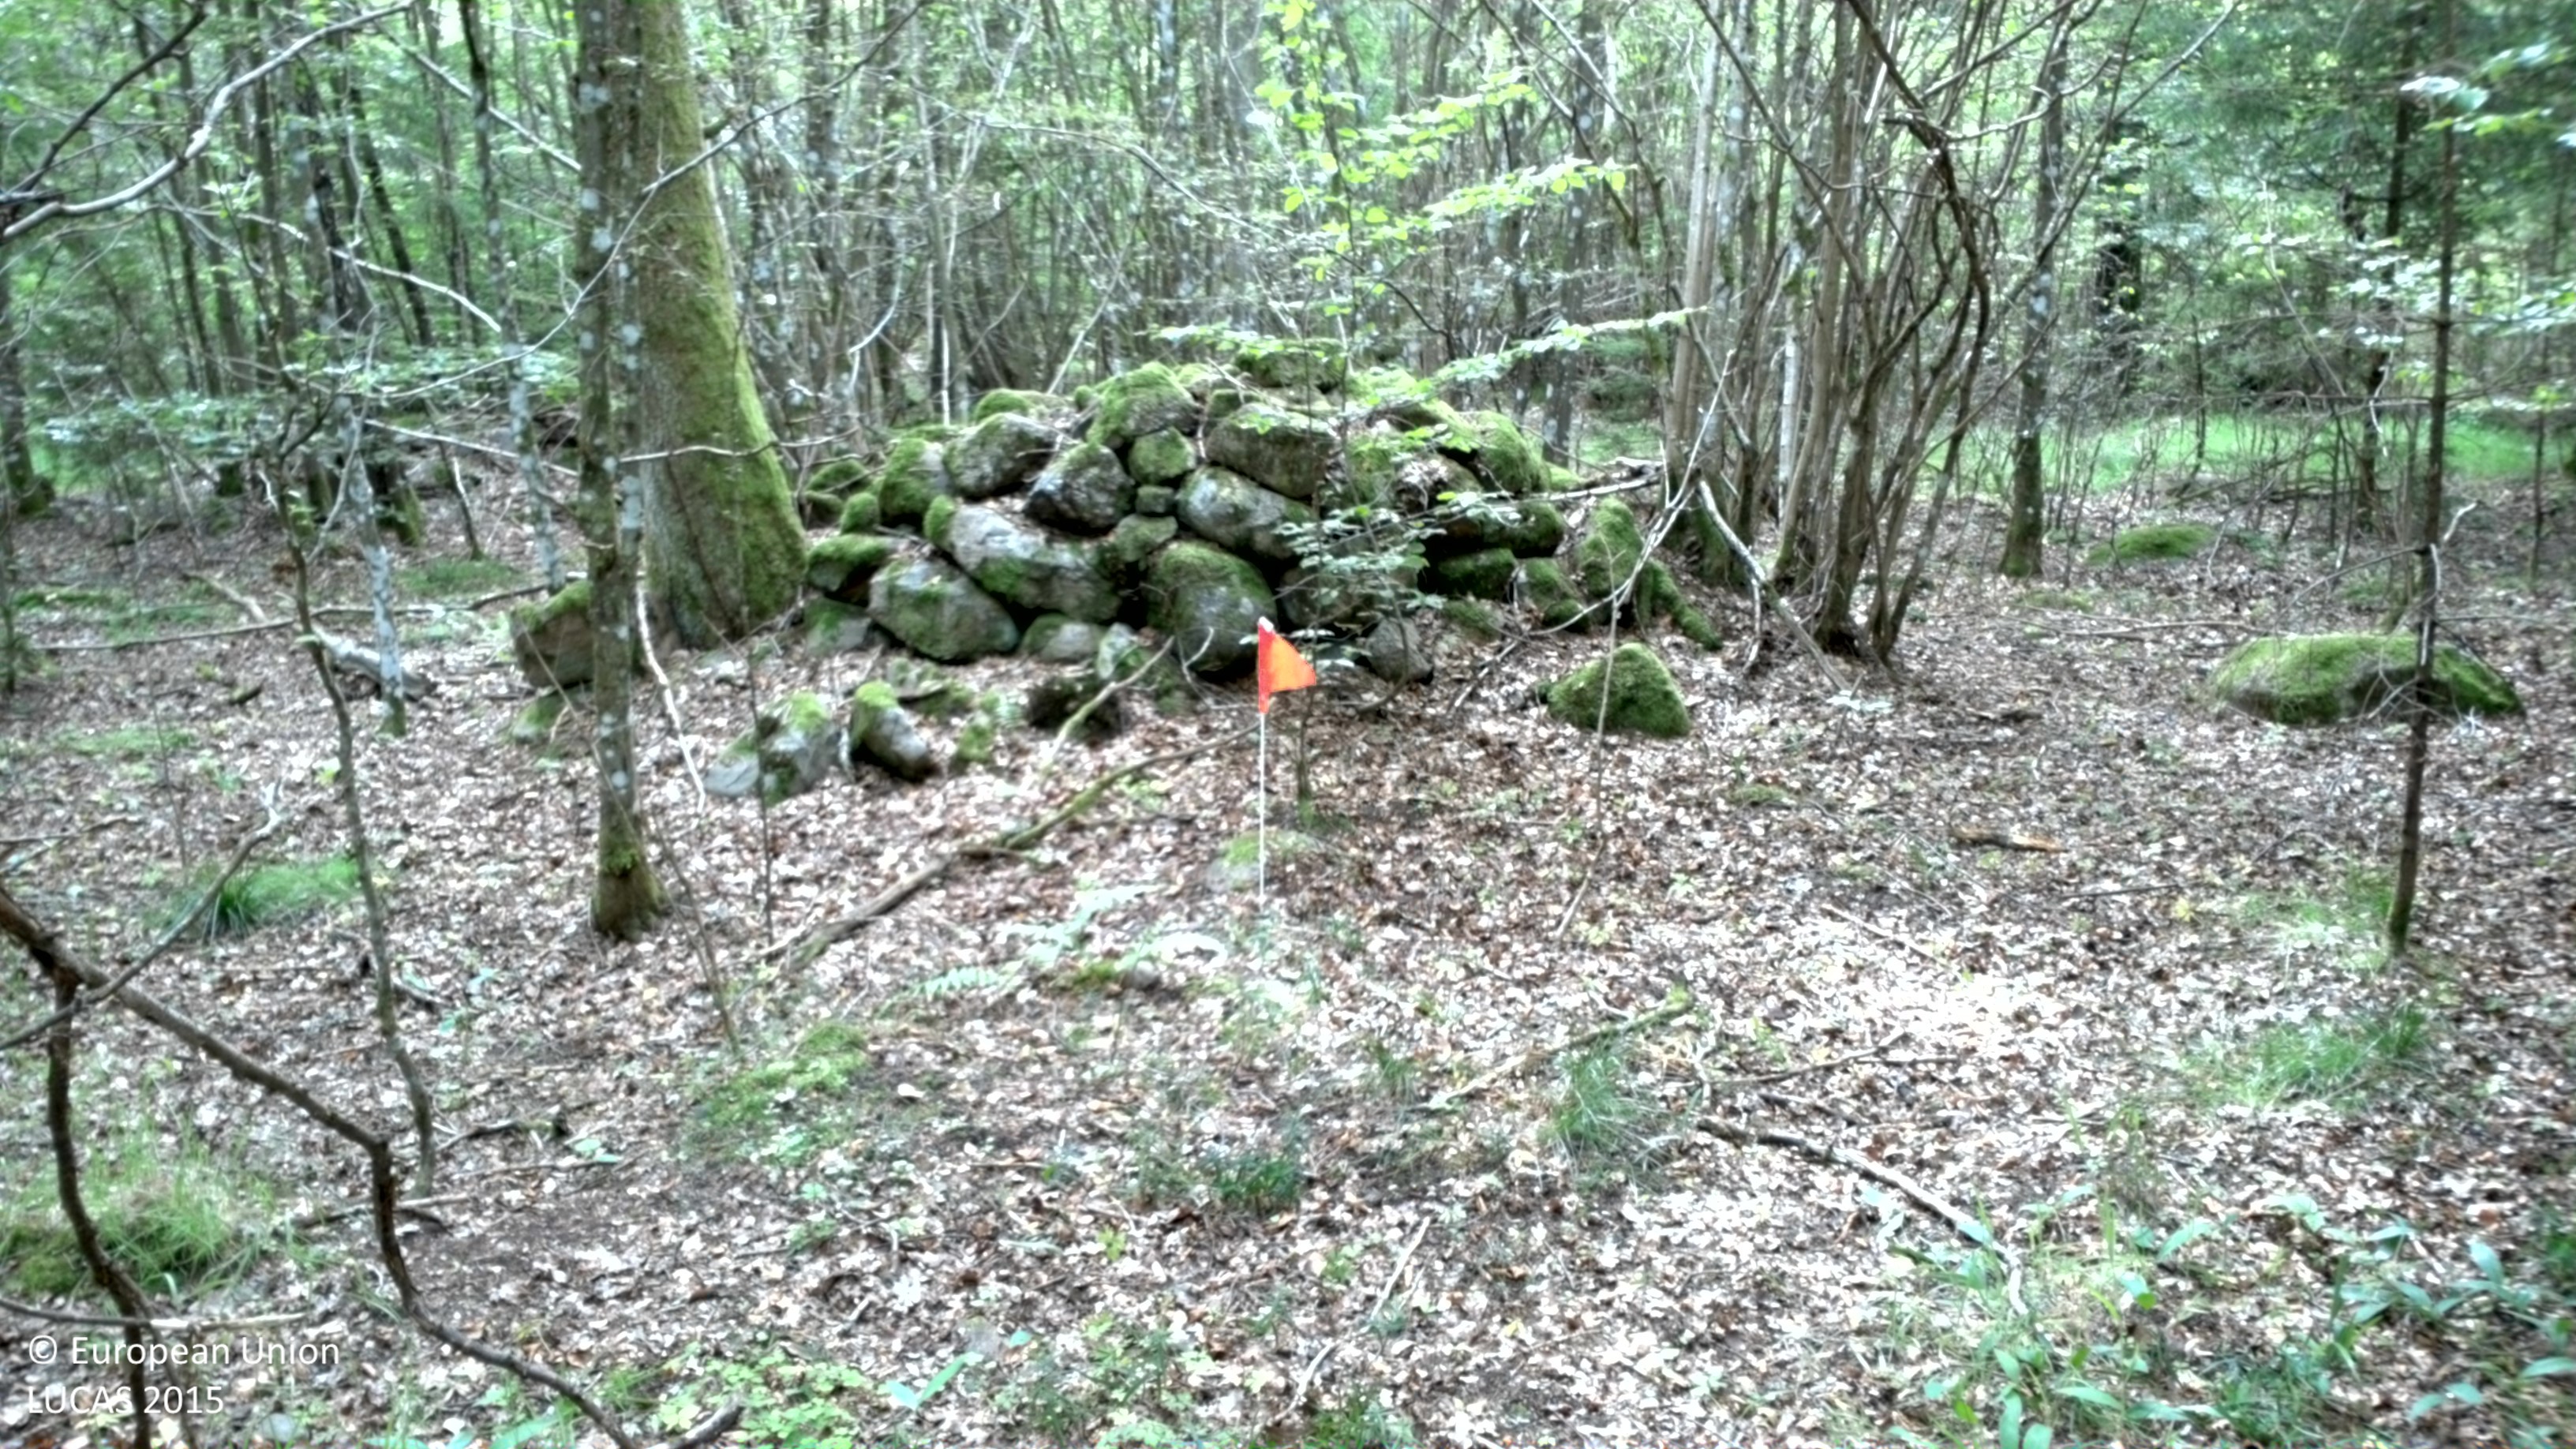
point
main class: Woodland
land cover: Broadleaved woodland
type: mesophytic deciduous forest
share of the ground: 50 - 75 %
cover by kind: broadleaved forest trees 50 %, shrubs 30 %, herbaceous plants 15 %, coniferous forest trees 5 %
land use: Forestry
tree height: > 5 m
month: July
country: SE
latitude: 56.2528
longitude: 15.4387
